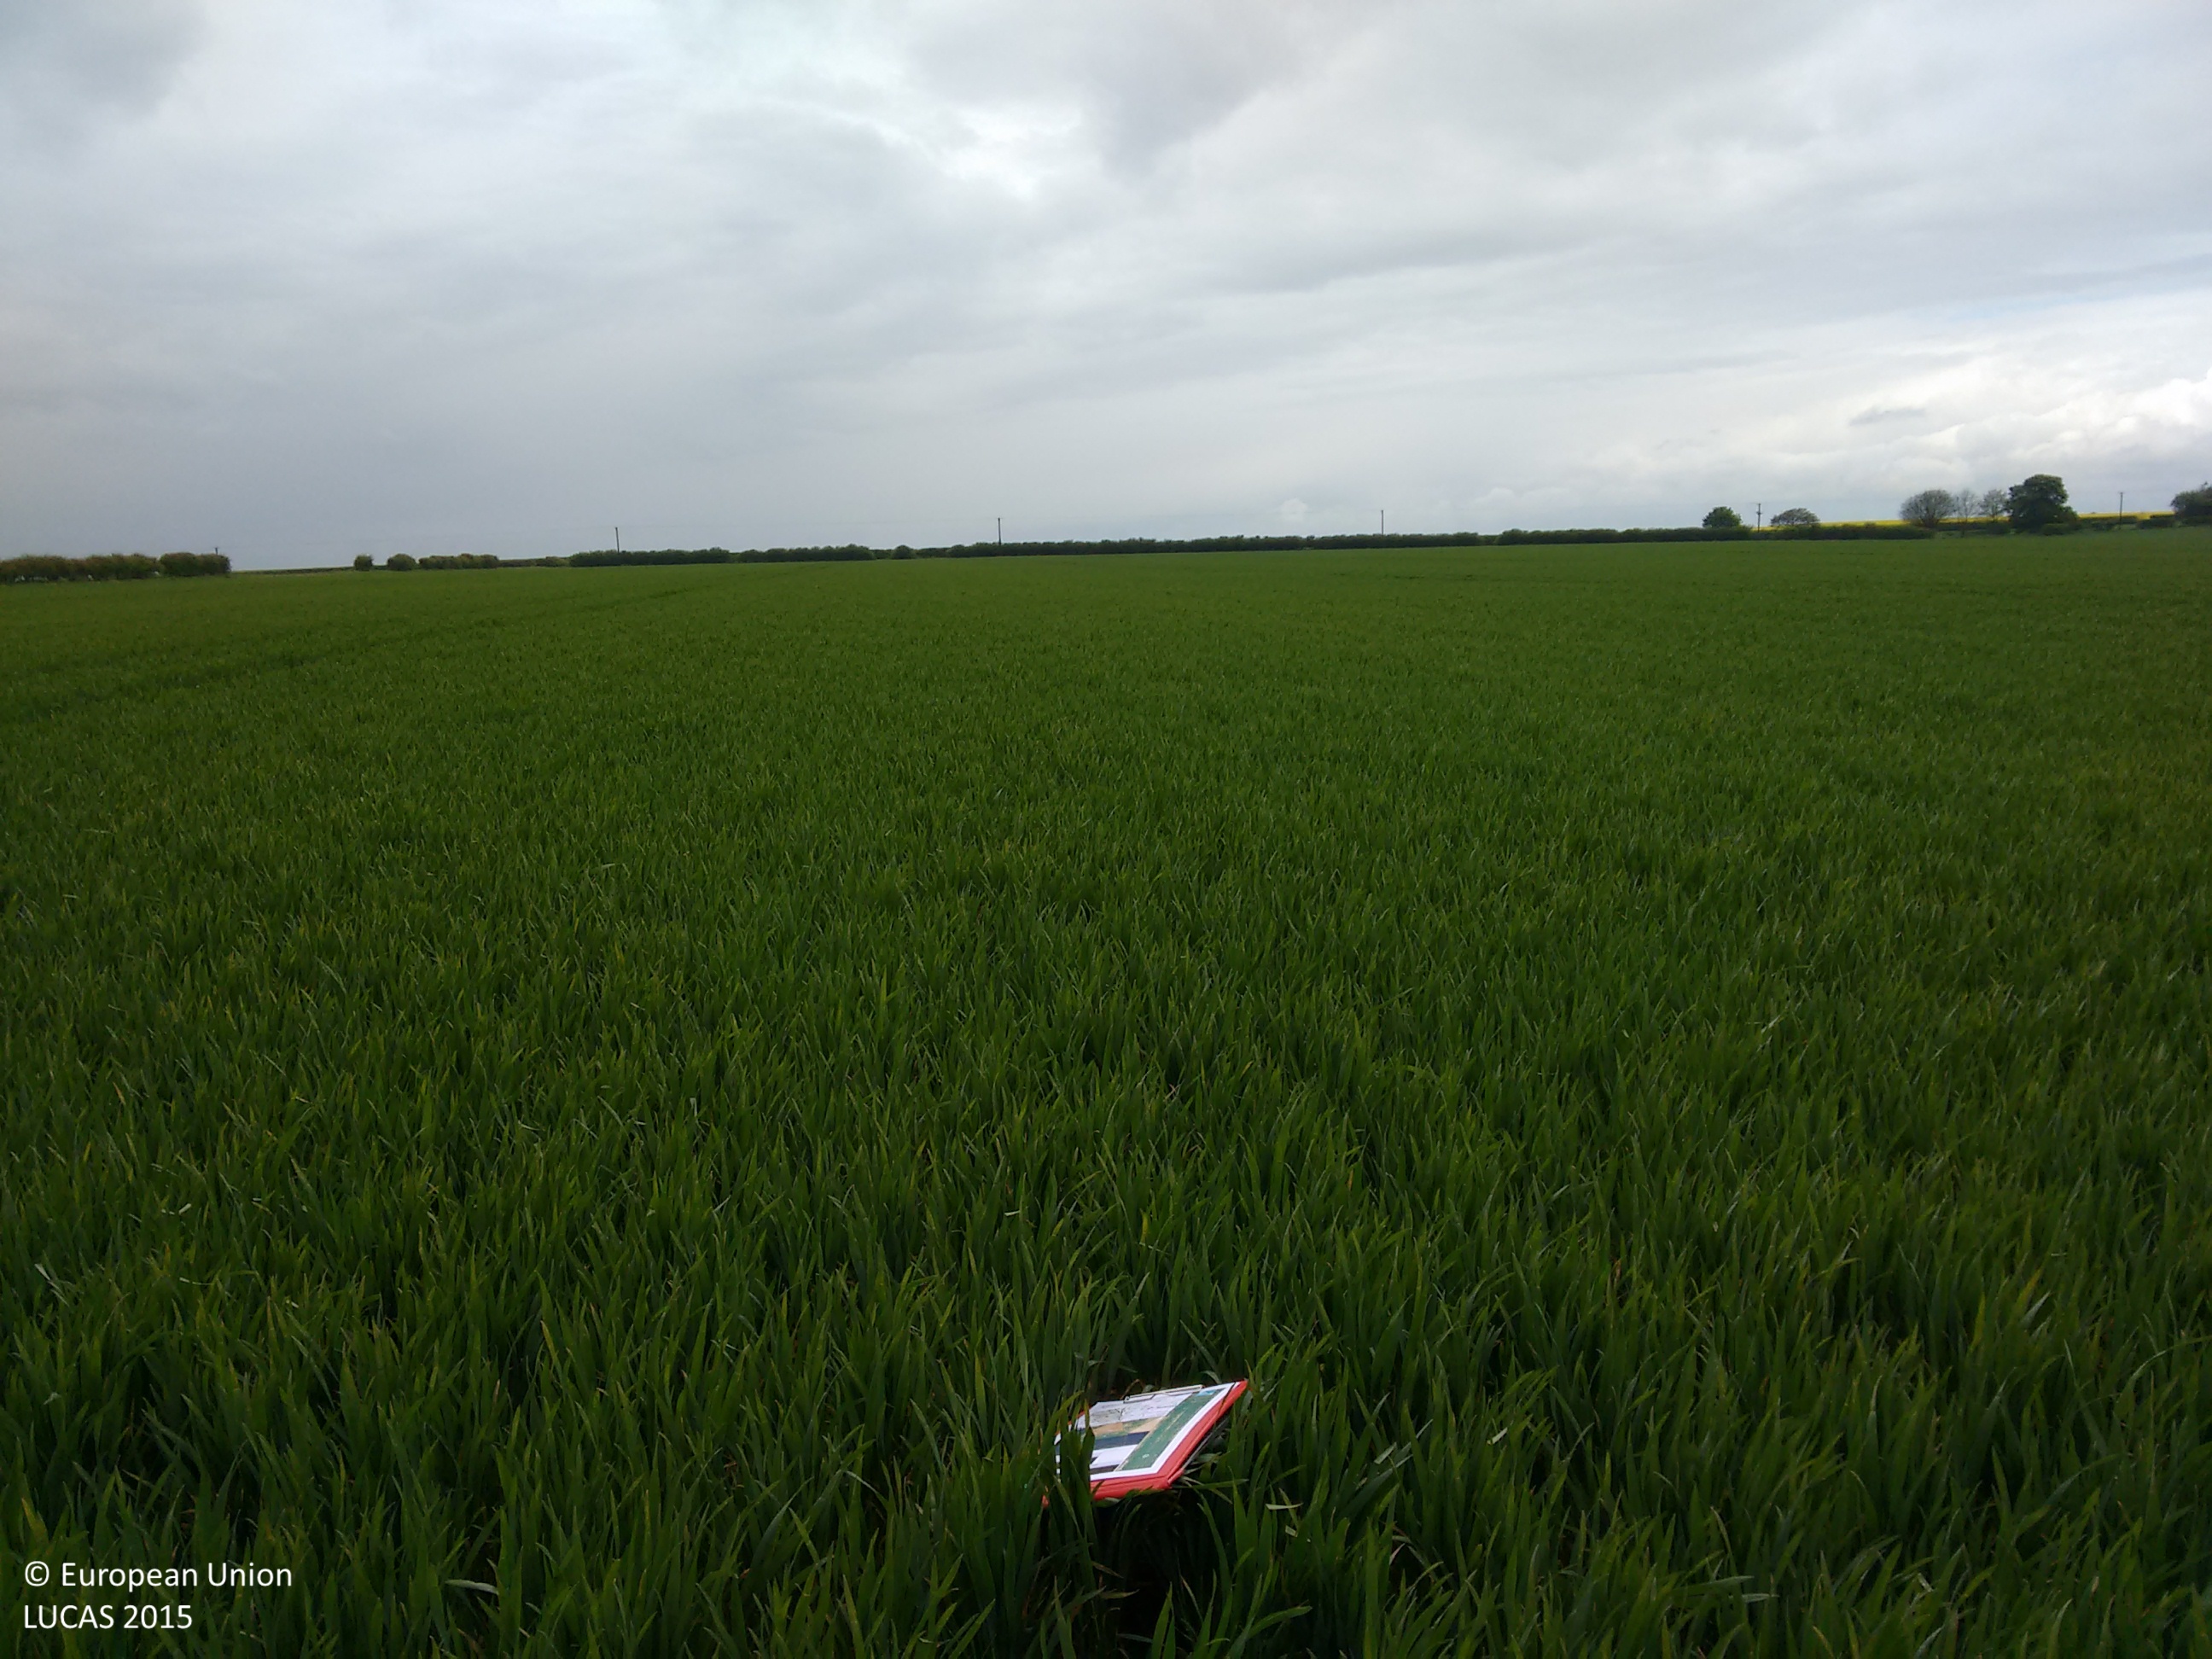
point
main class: Cropland
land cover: Barley
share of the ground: > 75 %
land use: Agriculture (excluding fallow land and kitchen gardens)
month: May
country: GB
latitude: 53.3910
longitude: -0.1533
